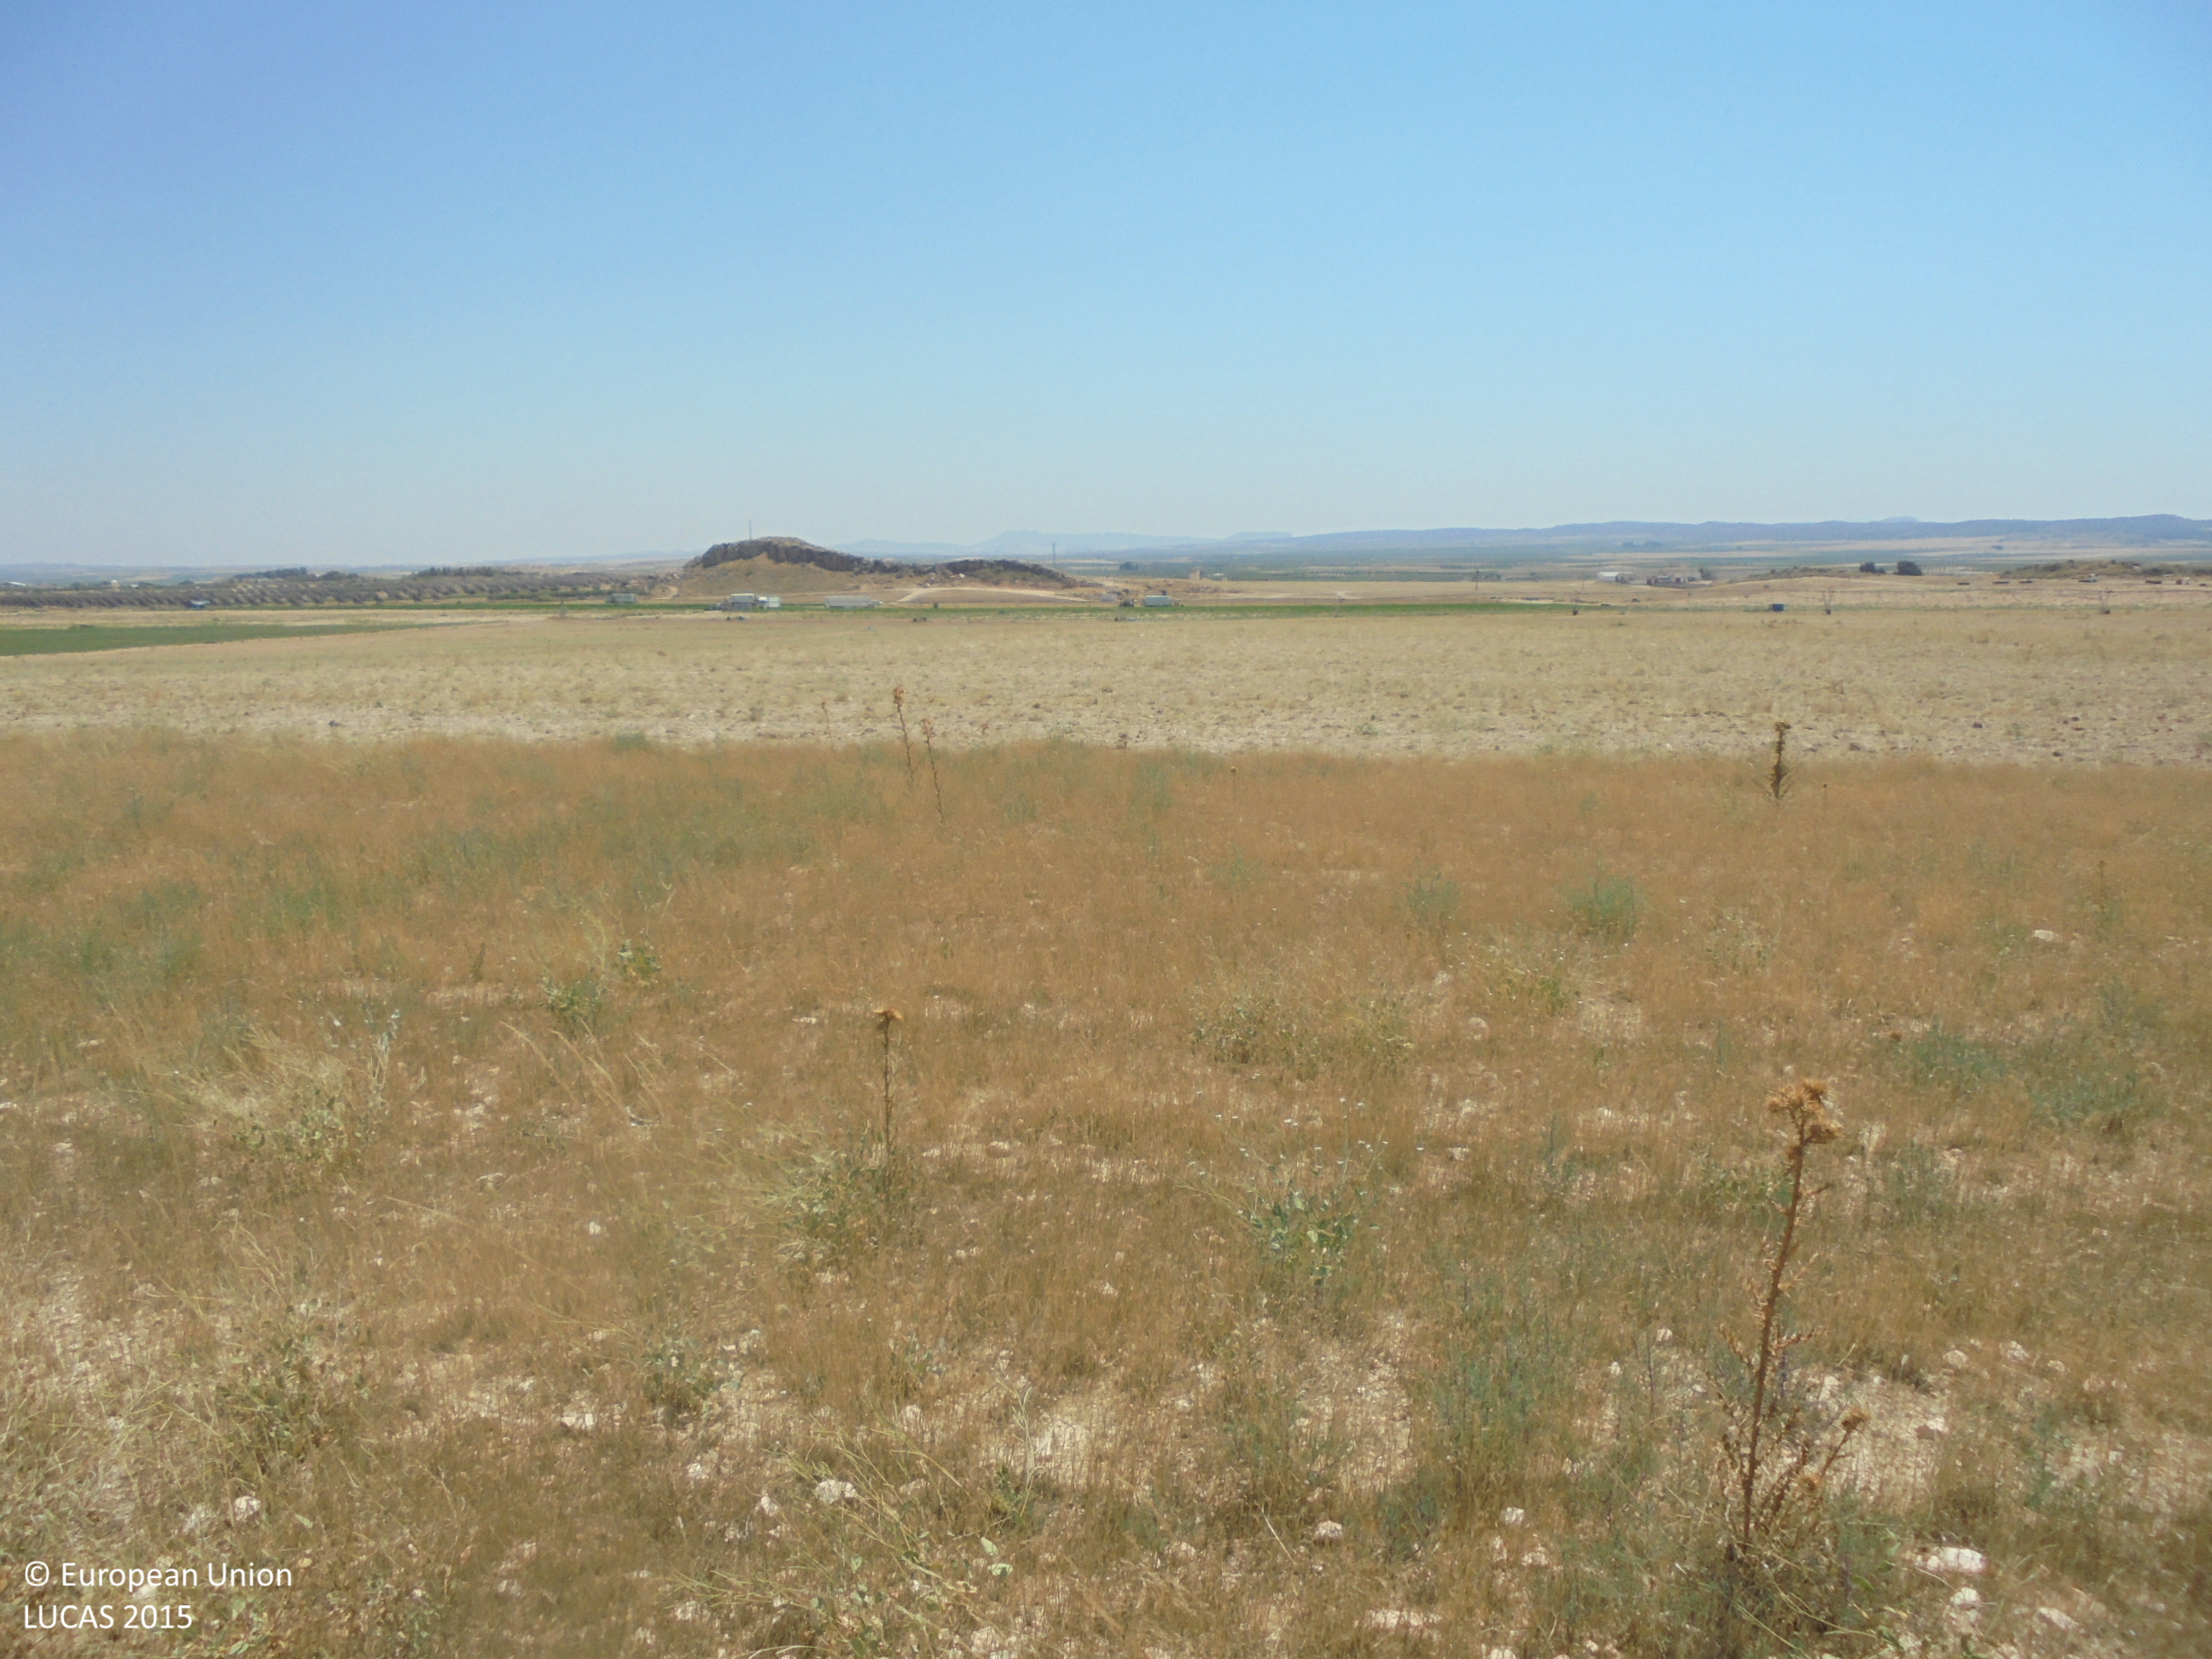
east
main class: Grassland
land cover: Spontaneously vegetated surfaces
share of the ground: > 75 %
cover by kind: herbaceous plants 80 %, unconsolidated bare surface 20 %
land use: Fallow land
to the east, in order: Spontaneously vegetated surfaces
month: July
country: ES
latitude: 38.5597
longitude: -1.5492
